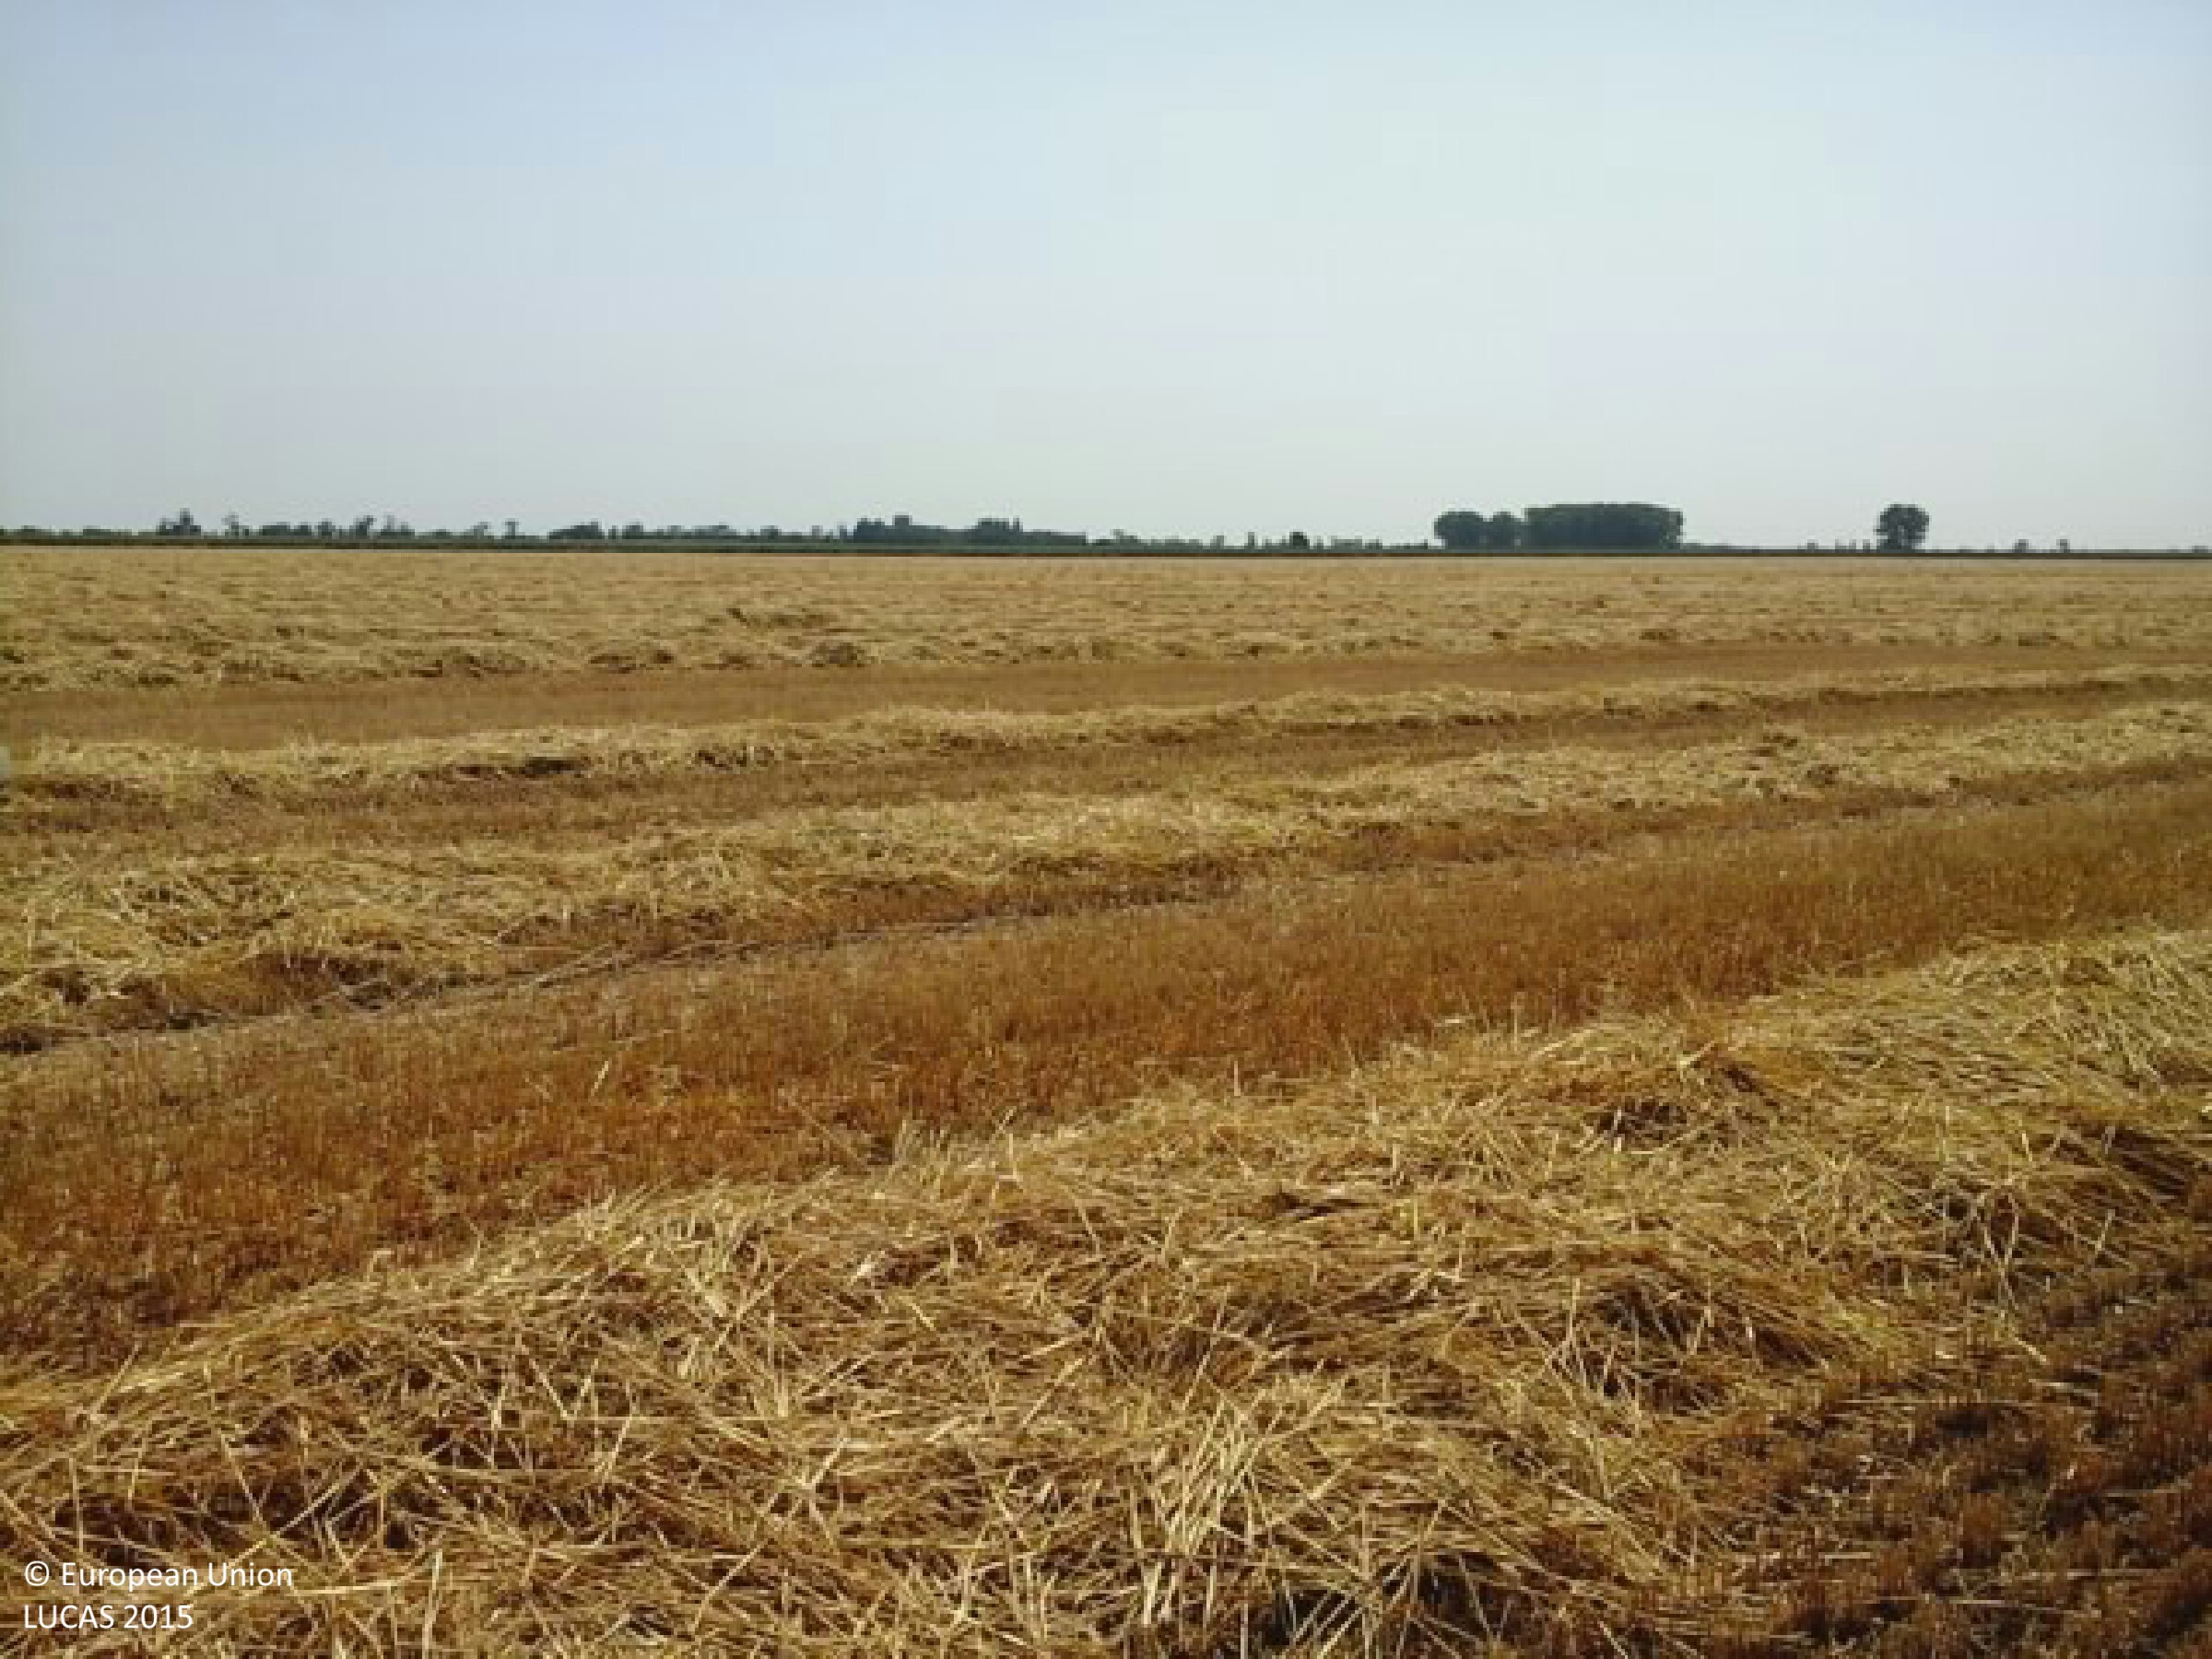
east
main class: Cropland
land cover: Common wheat
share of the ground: 50 - 75 %
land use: Agriculture (excluding fallow land and kitchen gardens)
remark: Harvested field
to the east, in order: Common wheat
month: July
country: HU
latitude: 46.3664
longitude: 21.1466
